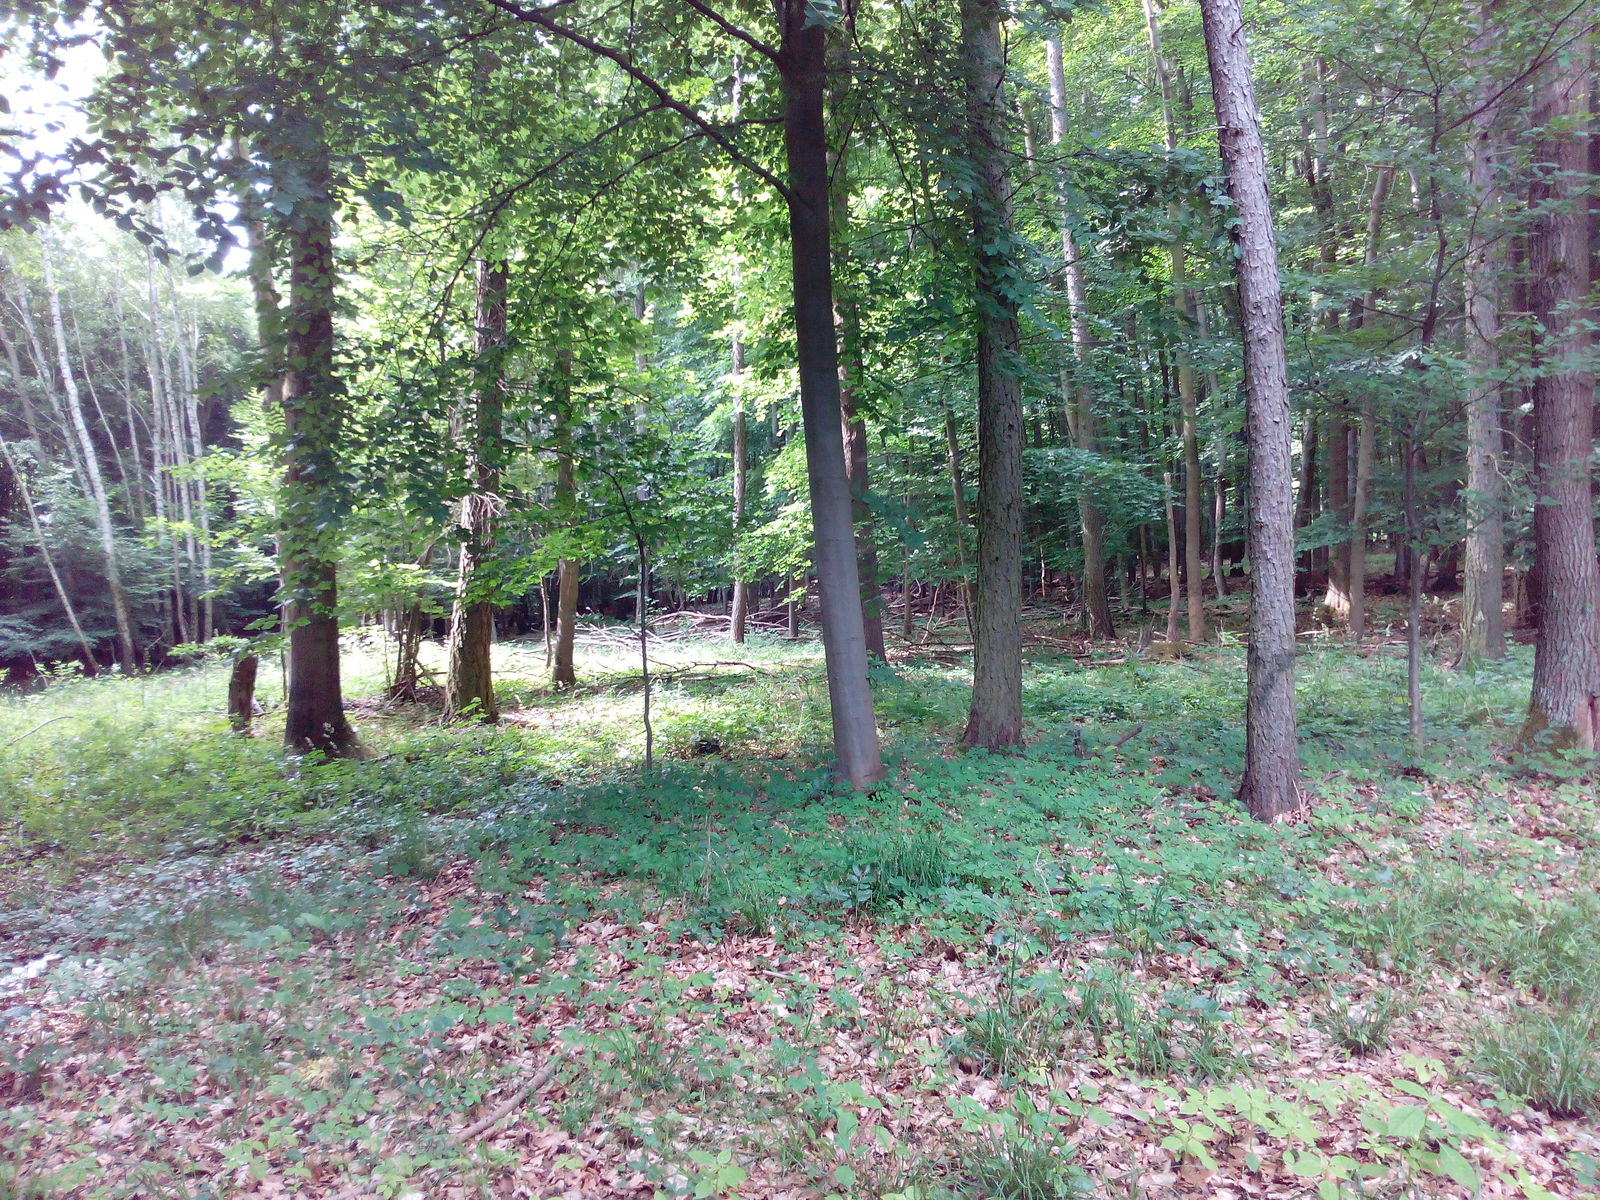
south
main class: Woodland
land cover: Broadleaved woodland
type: beech forest
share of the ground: > 75 %
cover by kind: broadleaved forest trees 90 %, herbaceous plants 10 %
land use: Forestry
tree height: > 5 m
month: June
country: DE
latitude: 51.3304
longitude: 11.0187
